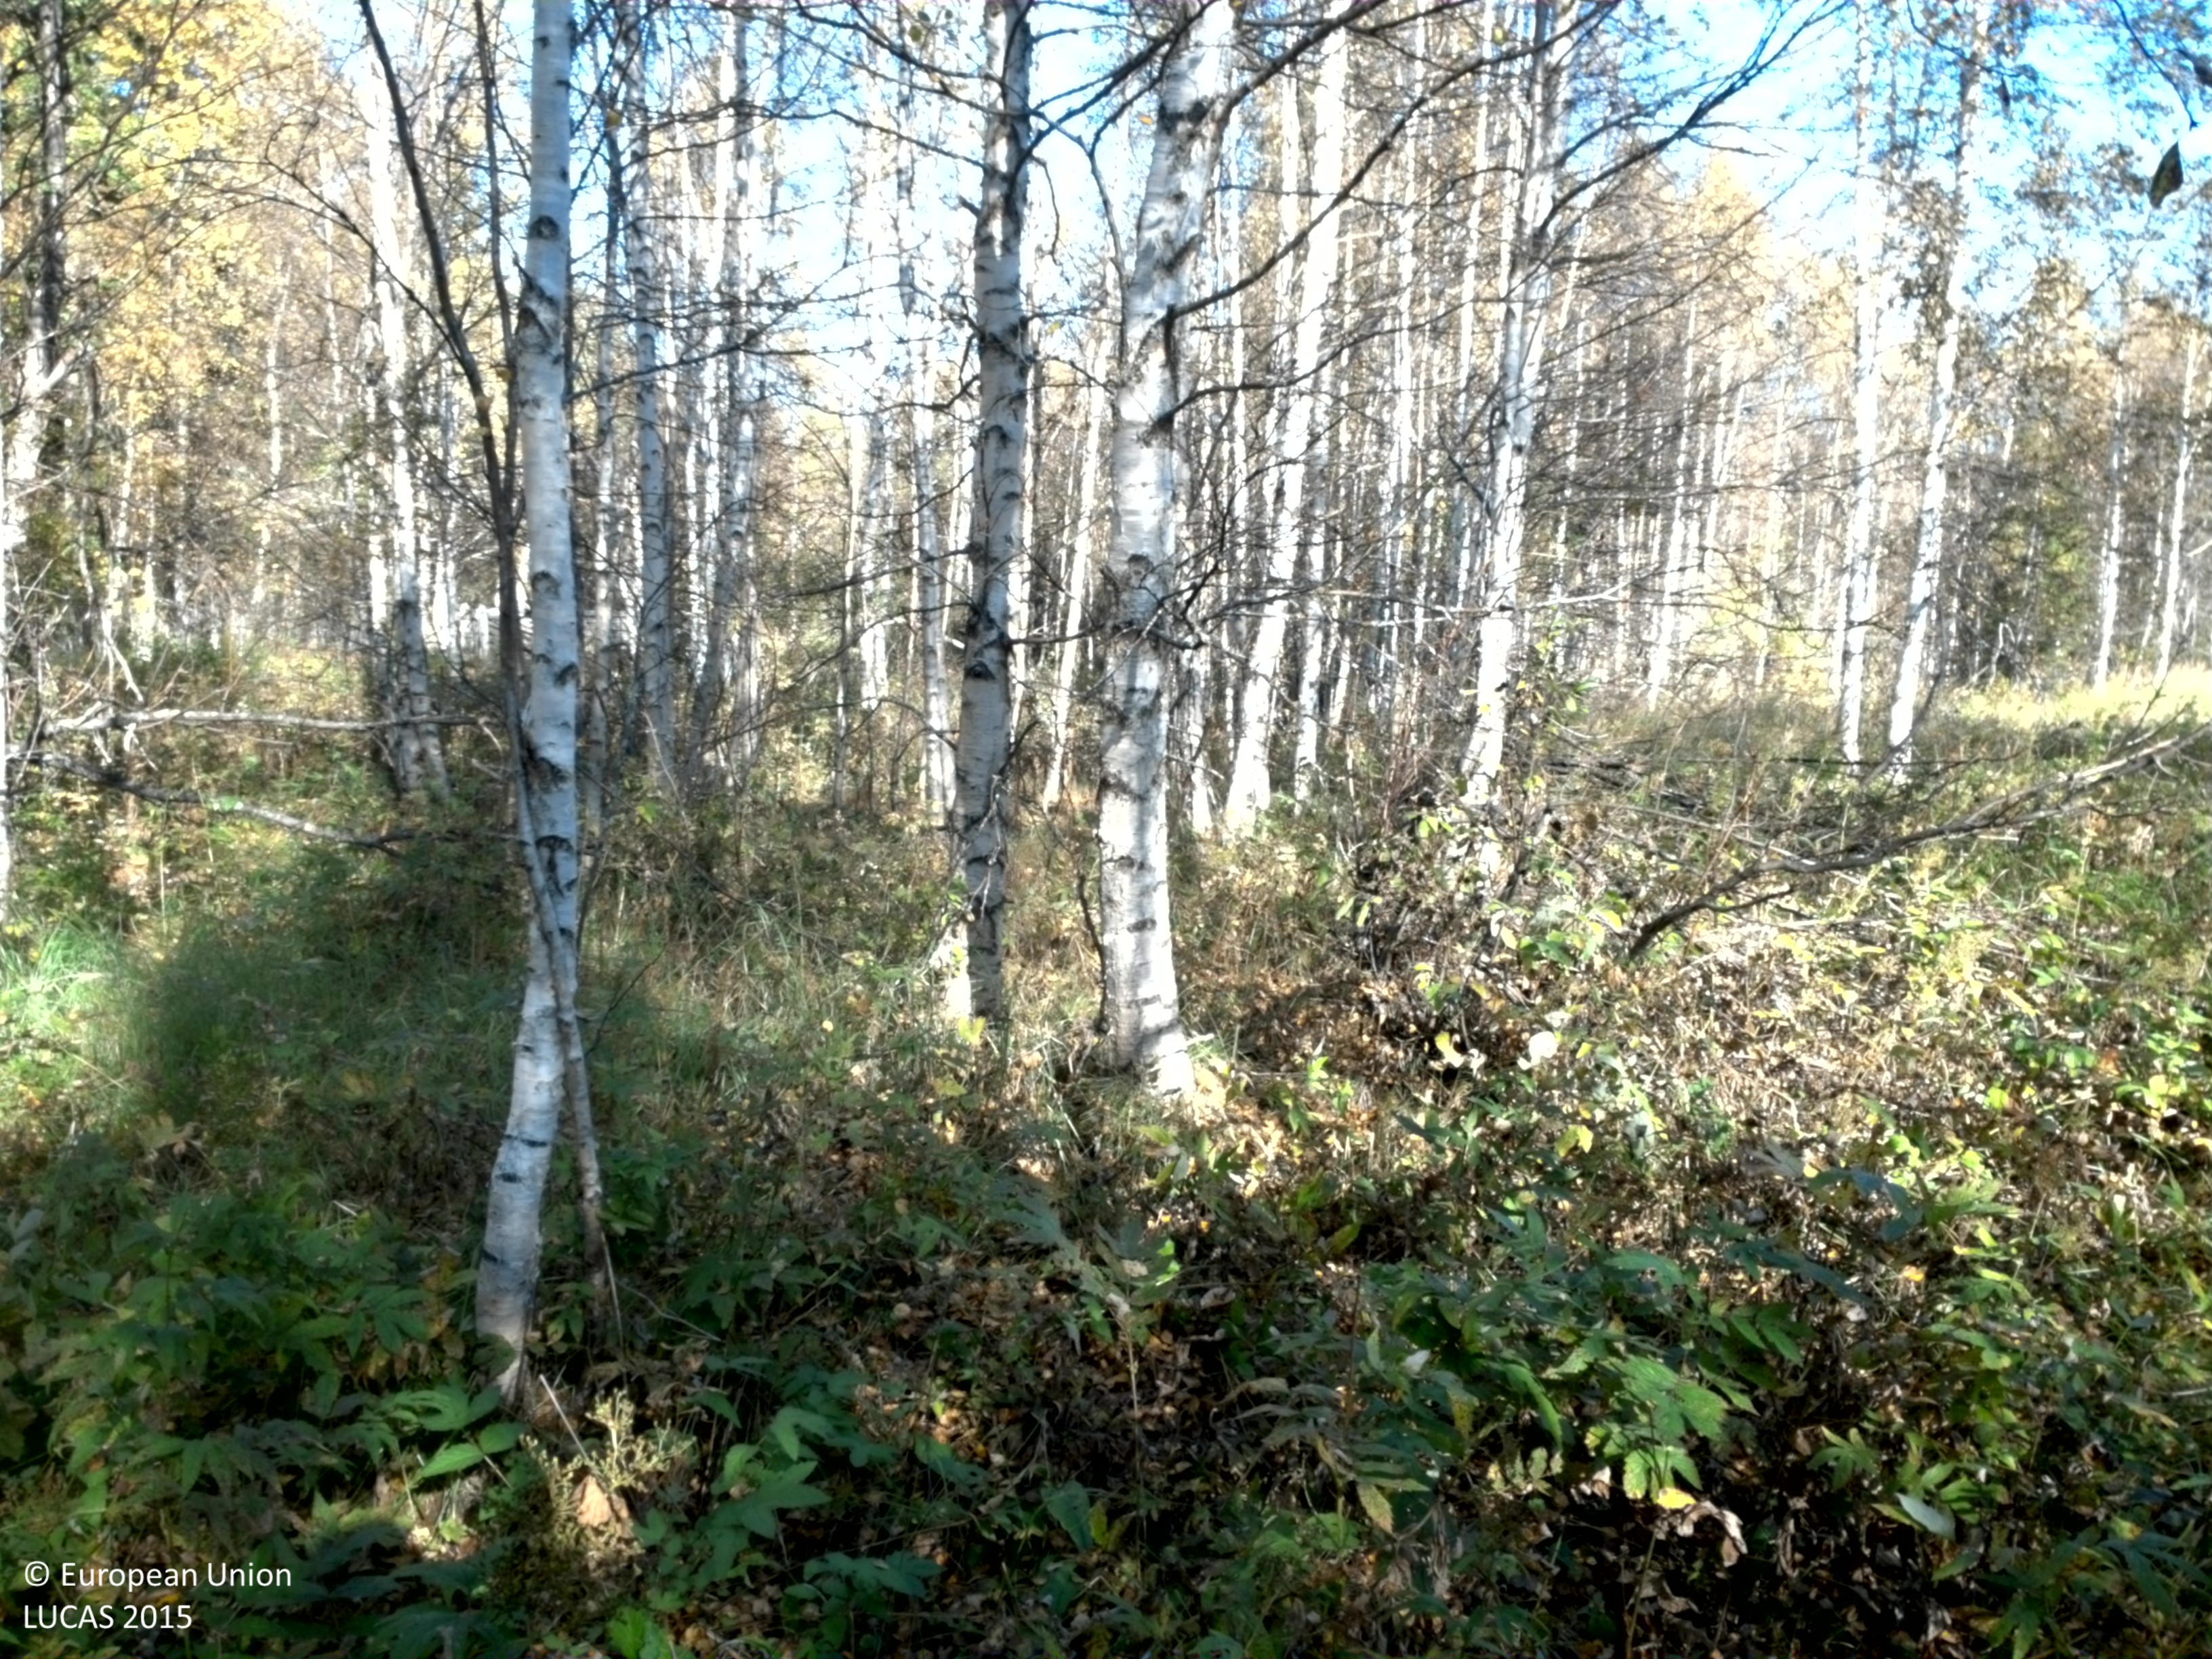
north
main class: Woodland
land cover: Broadleaved woodland
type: floodplain forest
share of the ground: 25 - 50 %
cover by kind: shrubs 40 %, broadleaved forest trees 30 %, herbaceous plants 30 %
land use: Forestry
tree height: > 5 m
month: September
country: SE
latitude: 65.8878
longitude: 22.1952
